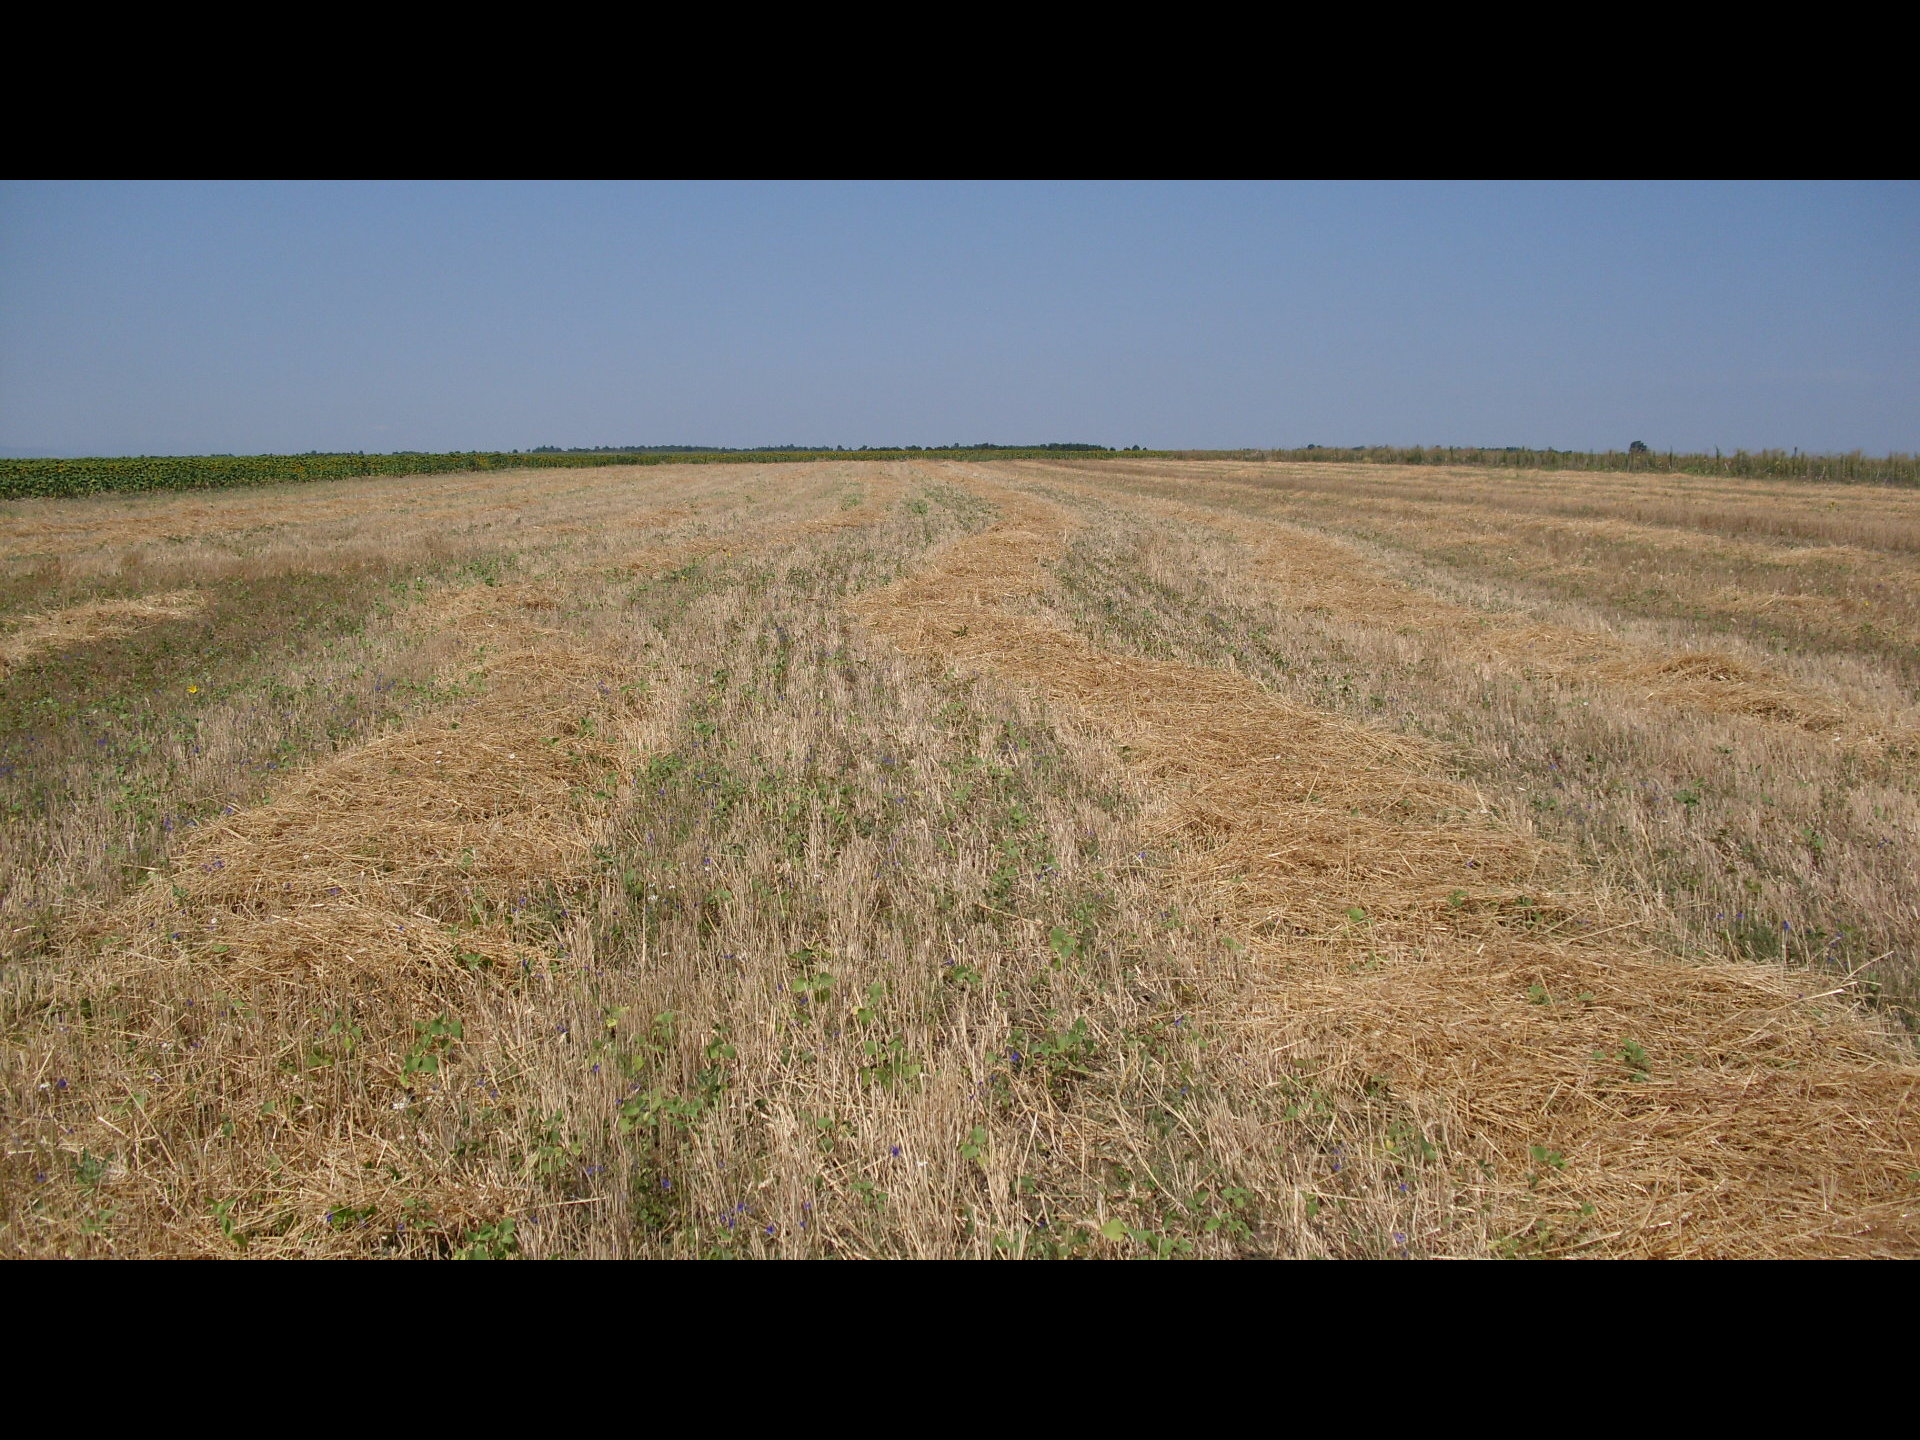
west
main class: Cropland
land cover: Common wheat
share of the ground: > 75 %
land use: Agriculture (excluding fallow land and kitchen gardens)
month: July
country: BG
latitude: 43.6529
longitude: 23.1714
